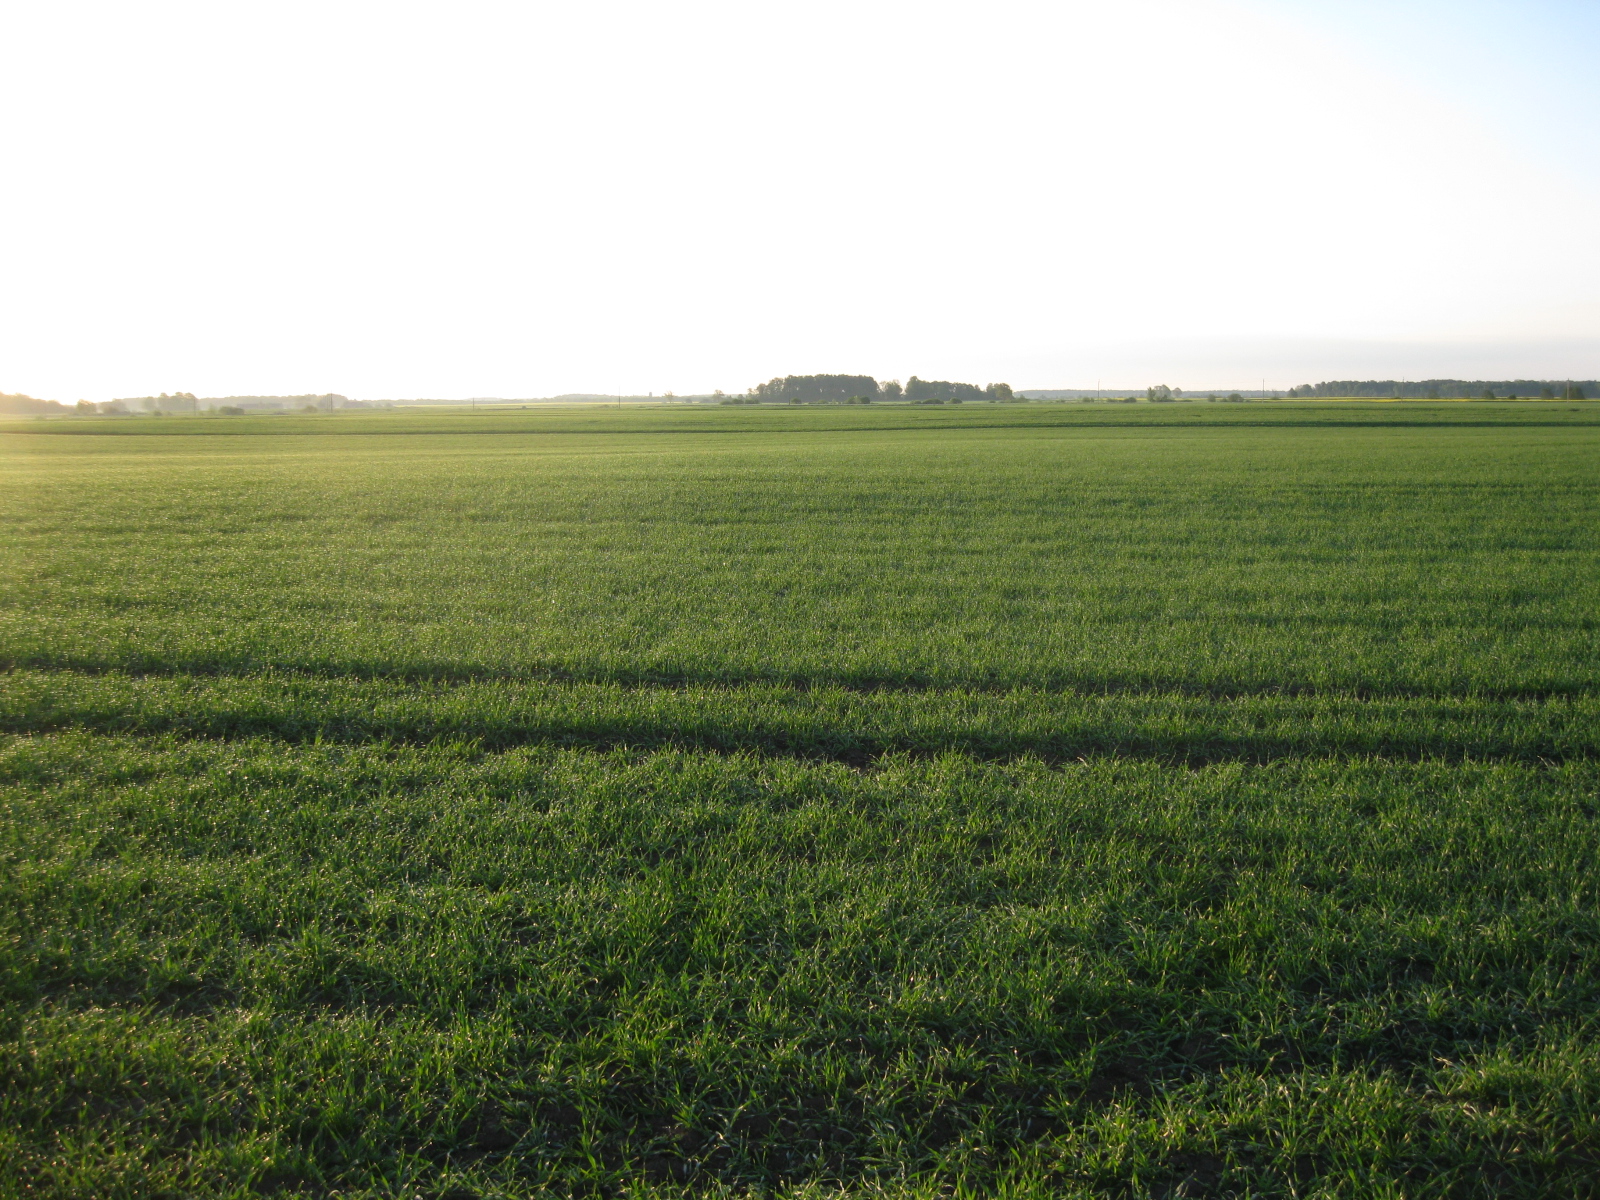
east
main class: Cropland
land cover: Barley
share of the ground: > 75 %
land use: Agriculture (excluding fallow land and kitchen gardens)
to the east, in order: Barley; Common wheat; Barley
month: May
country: LT
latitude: 56.1133
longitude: 23.8005
